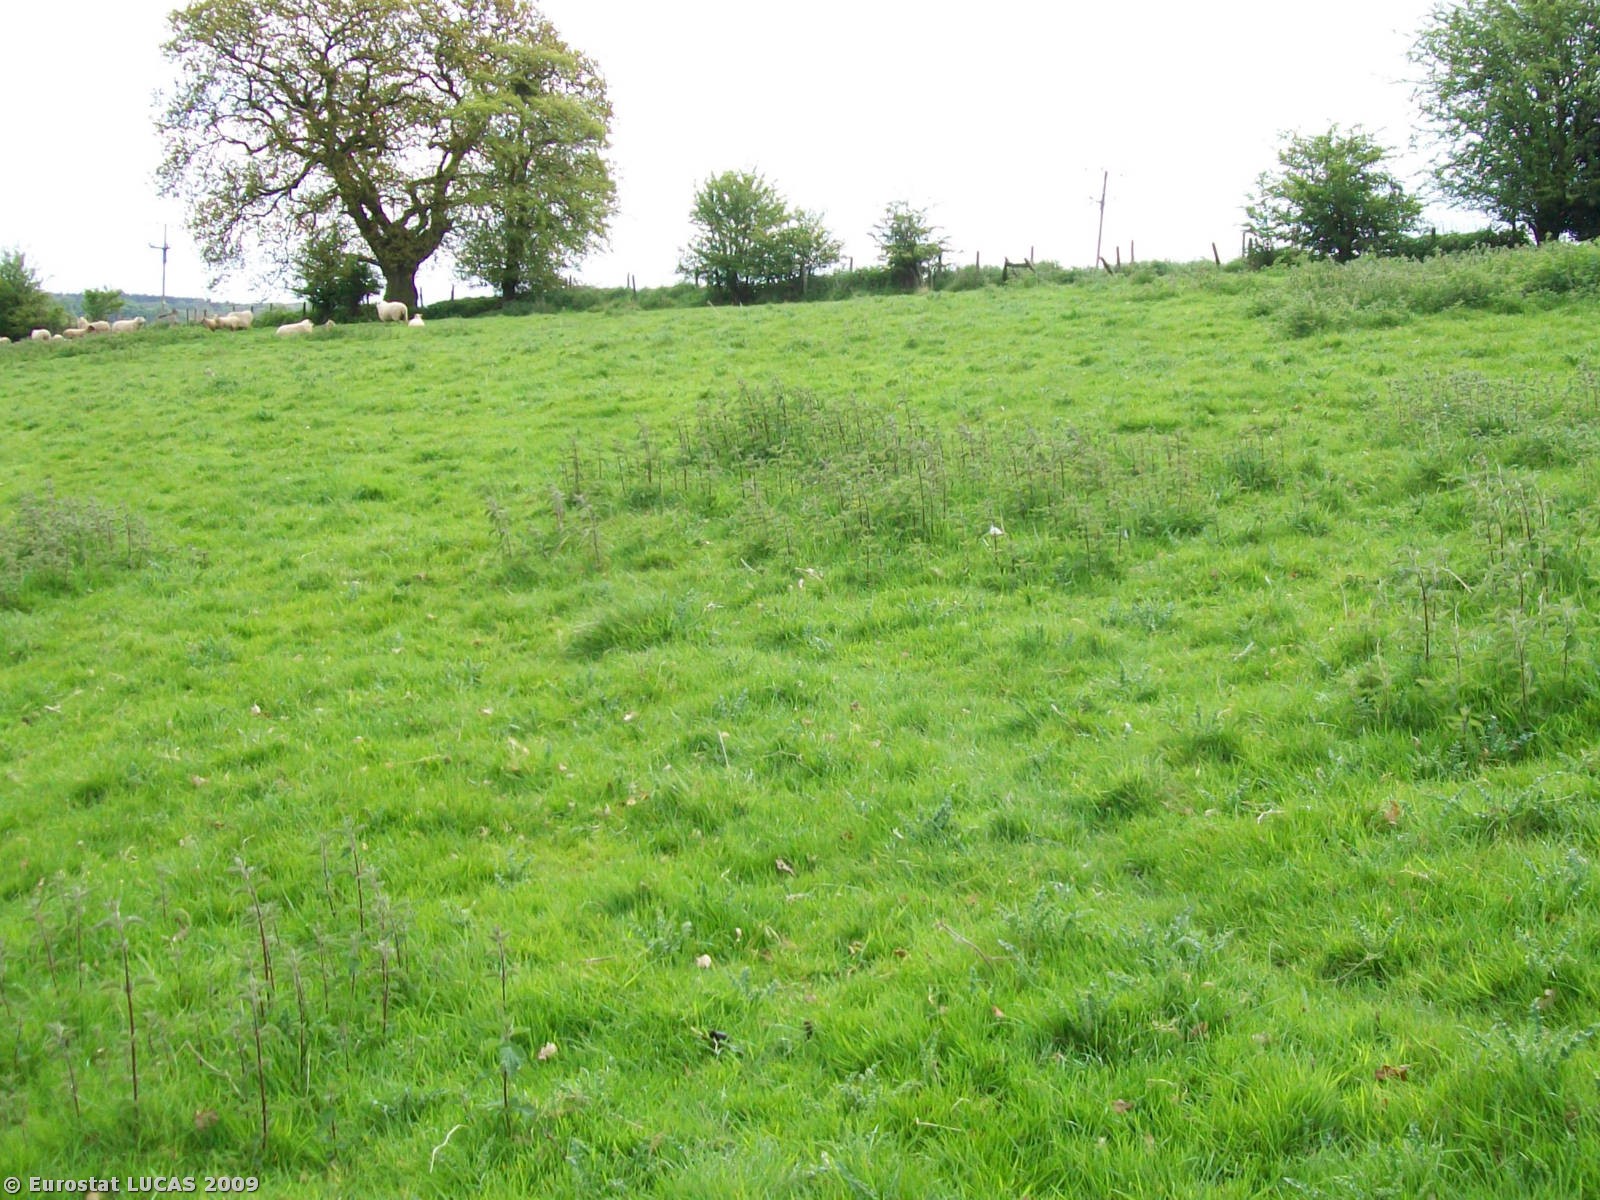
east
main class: Grassland
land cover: Grassland without tree/shrub cover
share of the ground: > 75 %
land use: Agriculture (excluding fallow land and kitchen gardens)
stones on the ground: < 10 %
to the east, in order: Grassland without tree/shrub cover; Fences; Grassland without tree/shrub cover
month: May
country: GB
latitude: 52.3712
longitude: -2.4772
